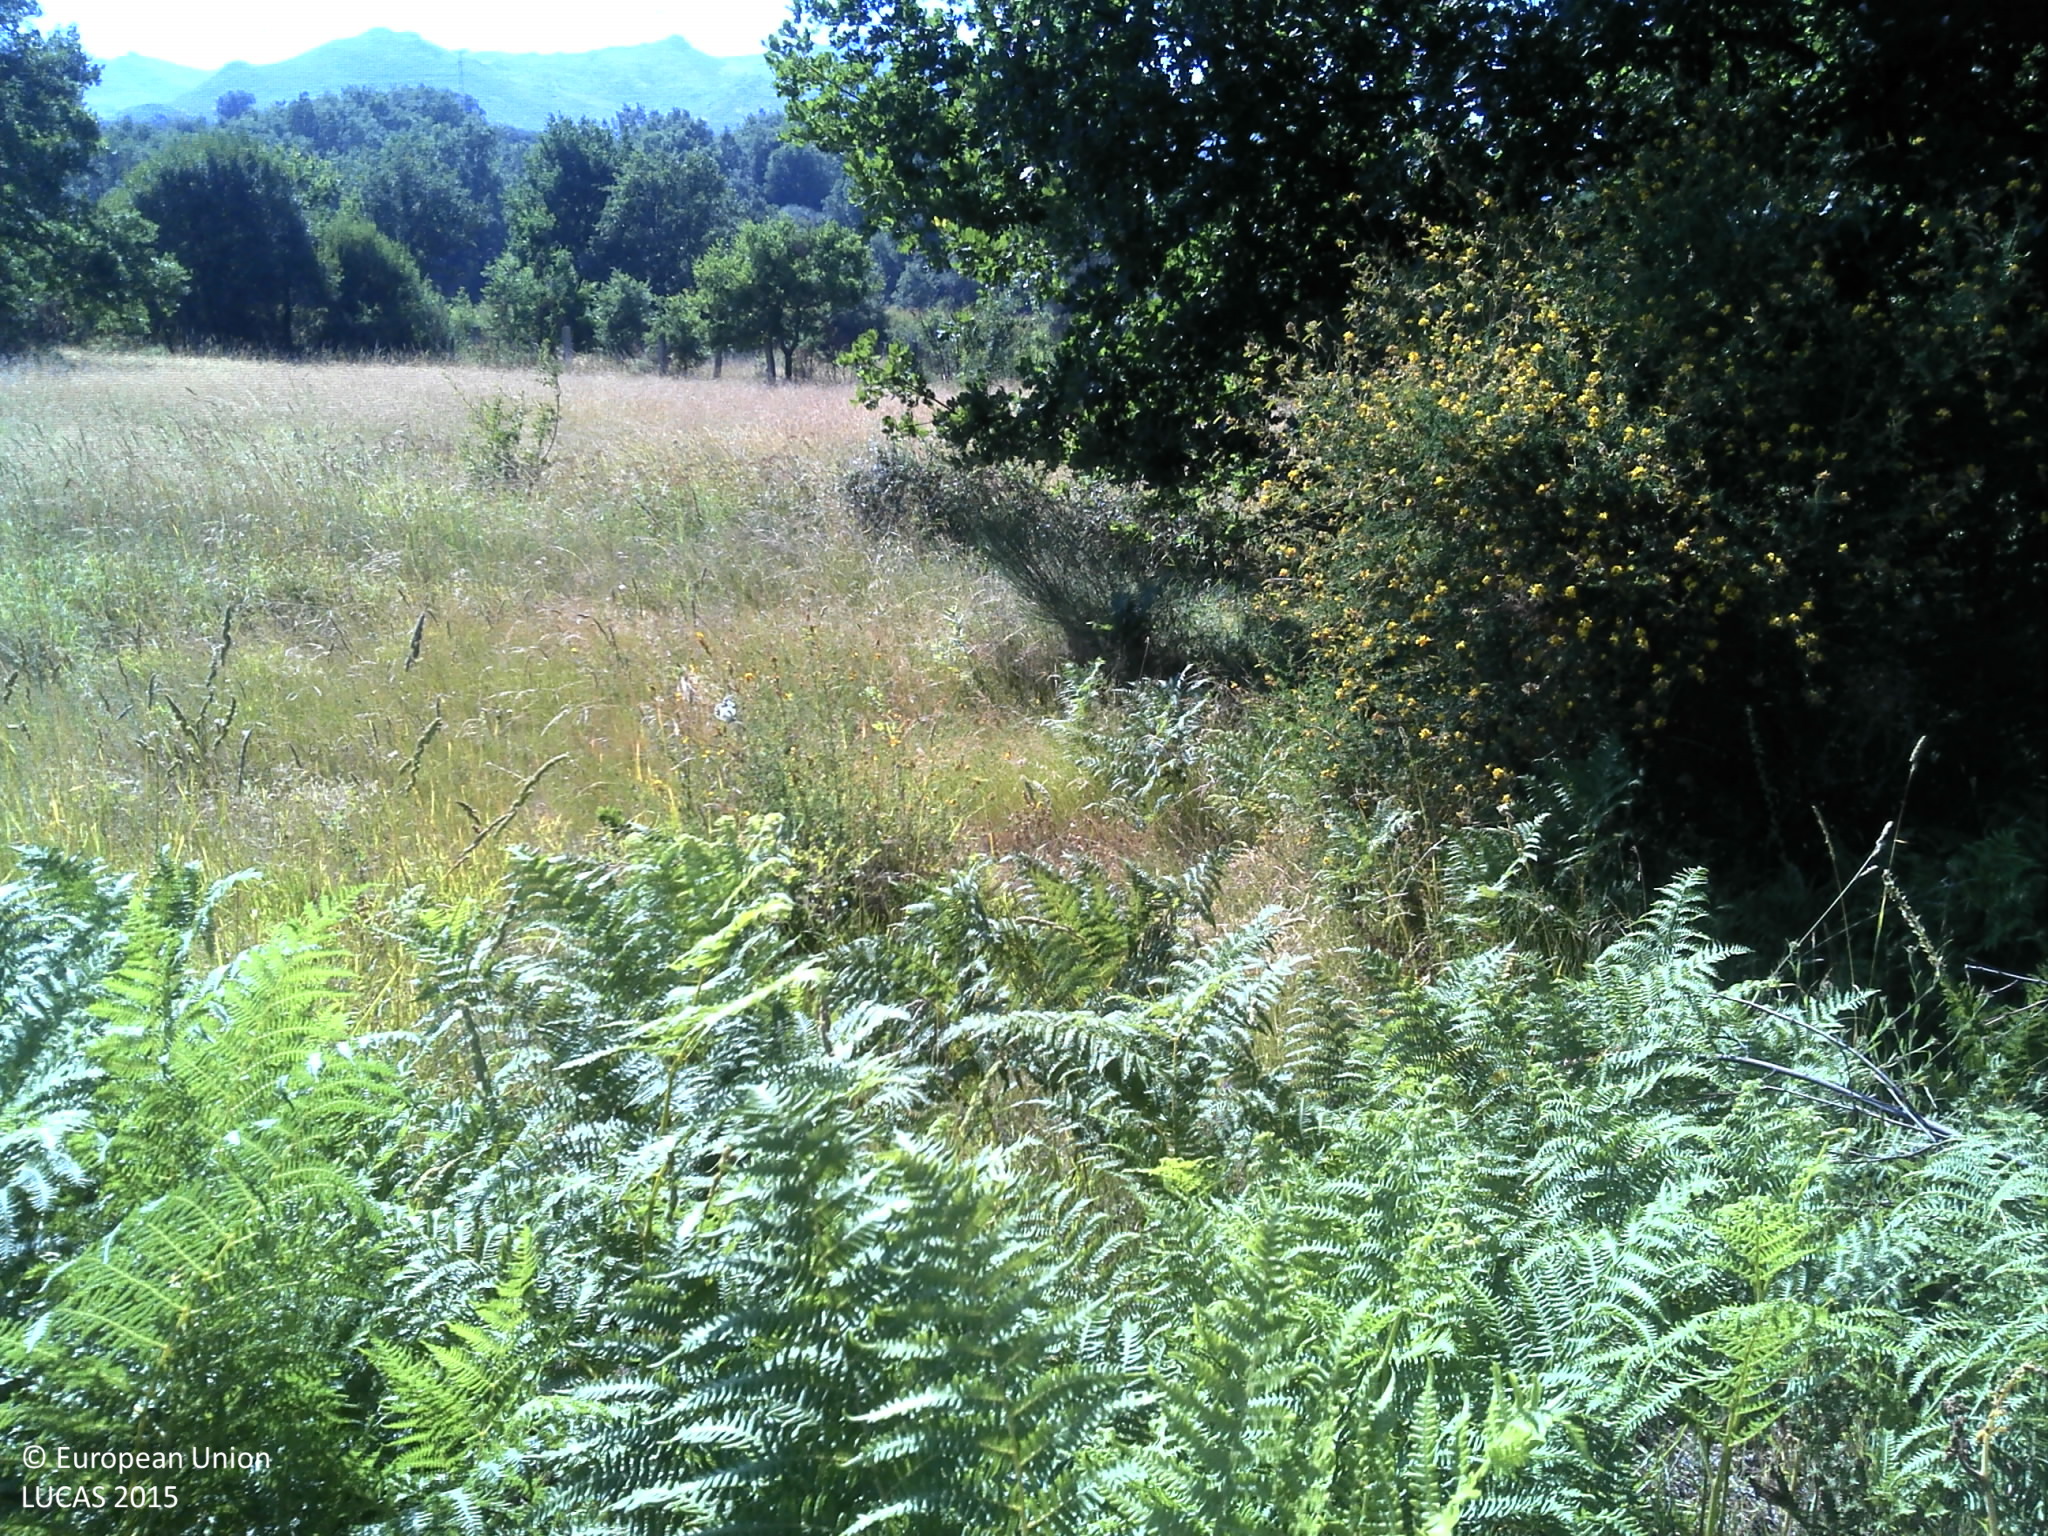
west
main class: Grassland
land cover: Spontaneously vegetated surfaces
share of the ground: > 75 %
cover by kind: herbaceous plants 90 %, shrubs 5 %, unconsolidated bare surface 5 %
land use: Fallow land
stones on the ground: < 10 %
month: July
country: PT
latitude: 41.7430
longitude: -7.6054
